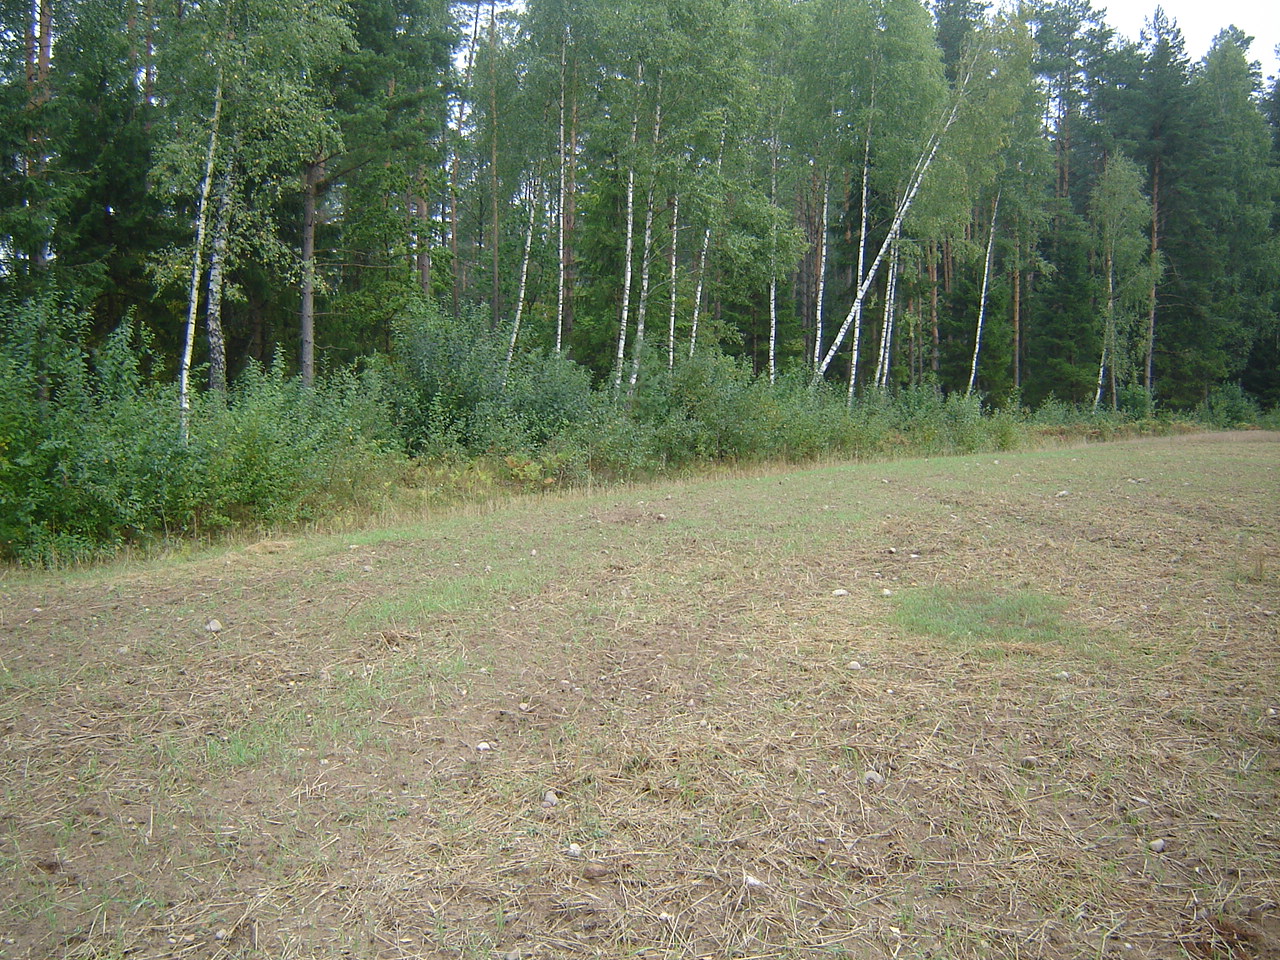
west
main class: Cropland
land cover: Rye
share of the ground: < 10 %
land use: Agriculture (excluding fallow land and kitchen gardens)
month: September
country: LT
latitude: 54.2290
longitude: 24.7593
